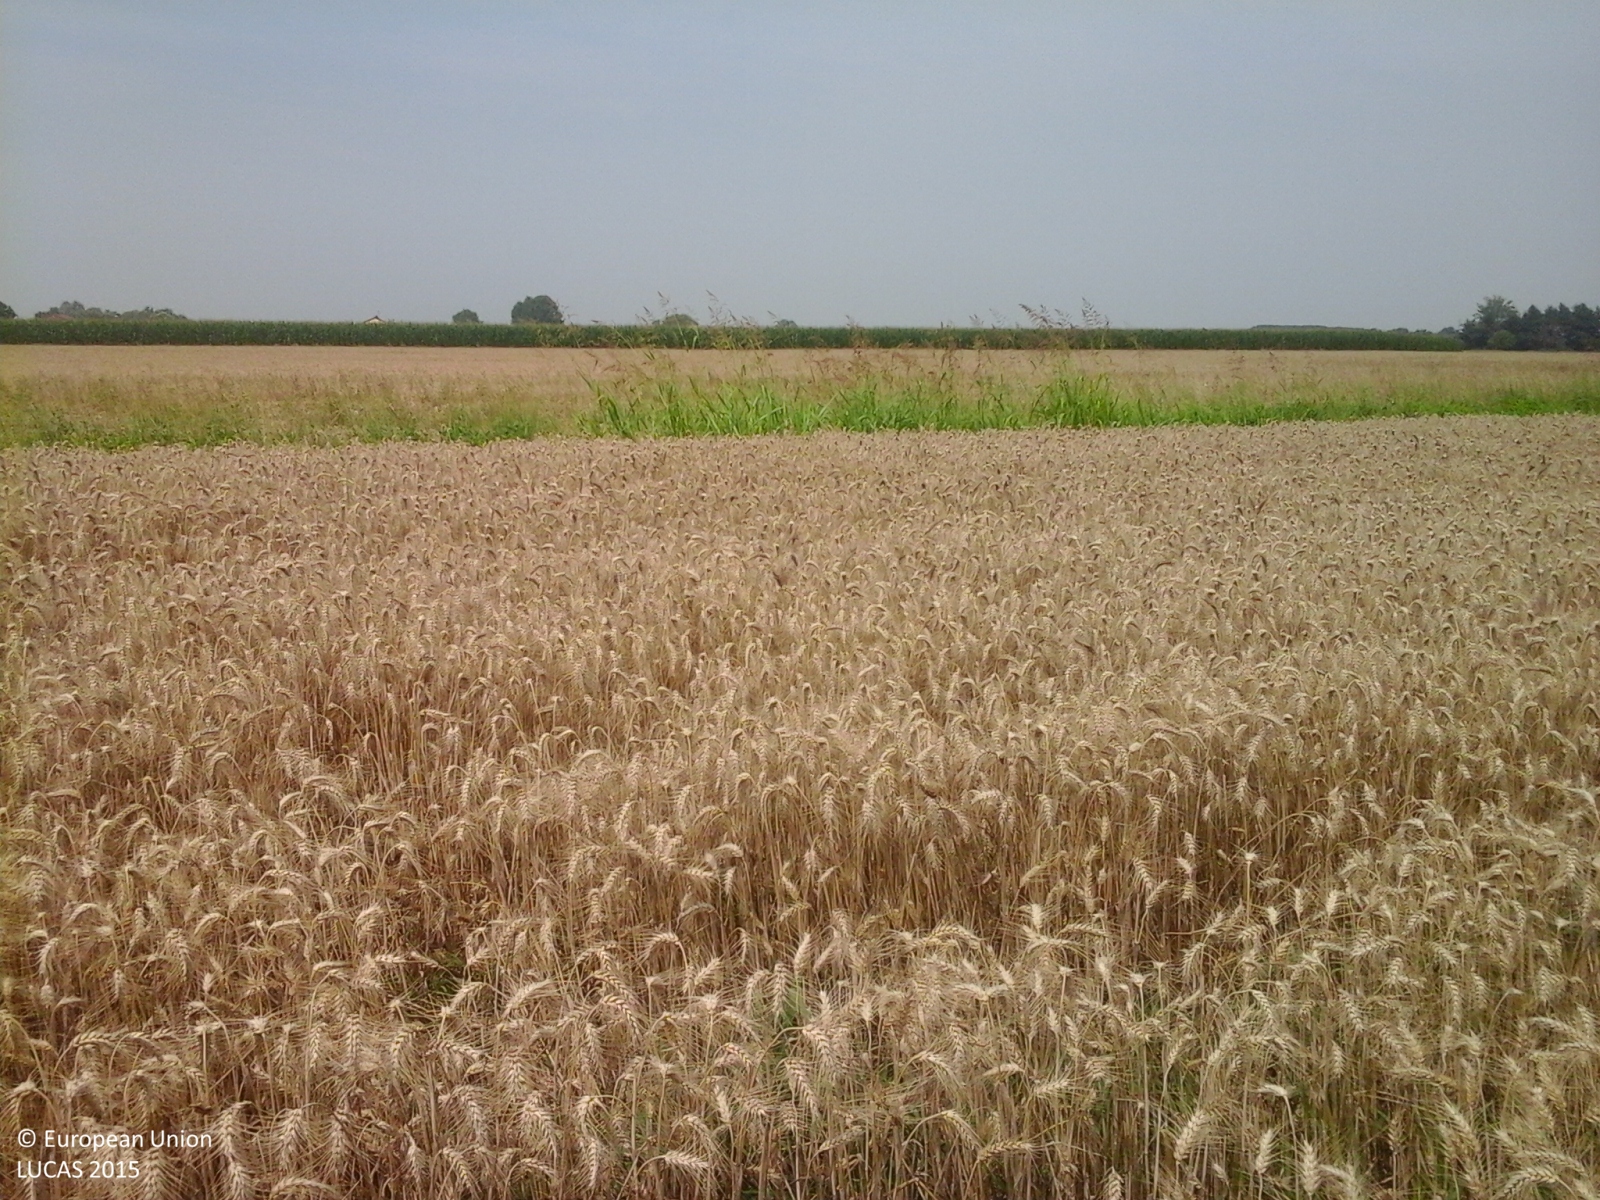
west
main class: Cropland
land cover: Common wheat
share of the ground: > 75 %
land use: Agriculture (excluding fallow land and kitchen gardens)
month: June
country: IT
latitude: 44.9539
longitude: 8.5704
